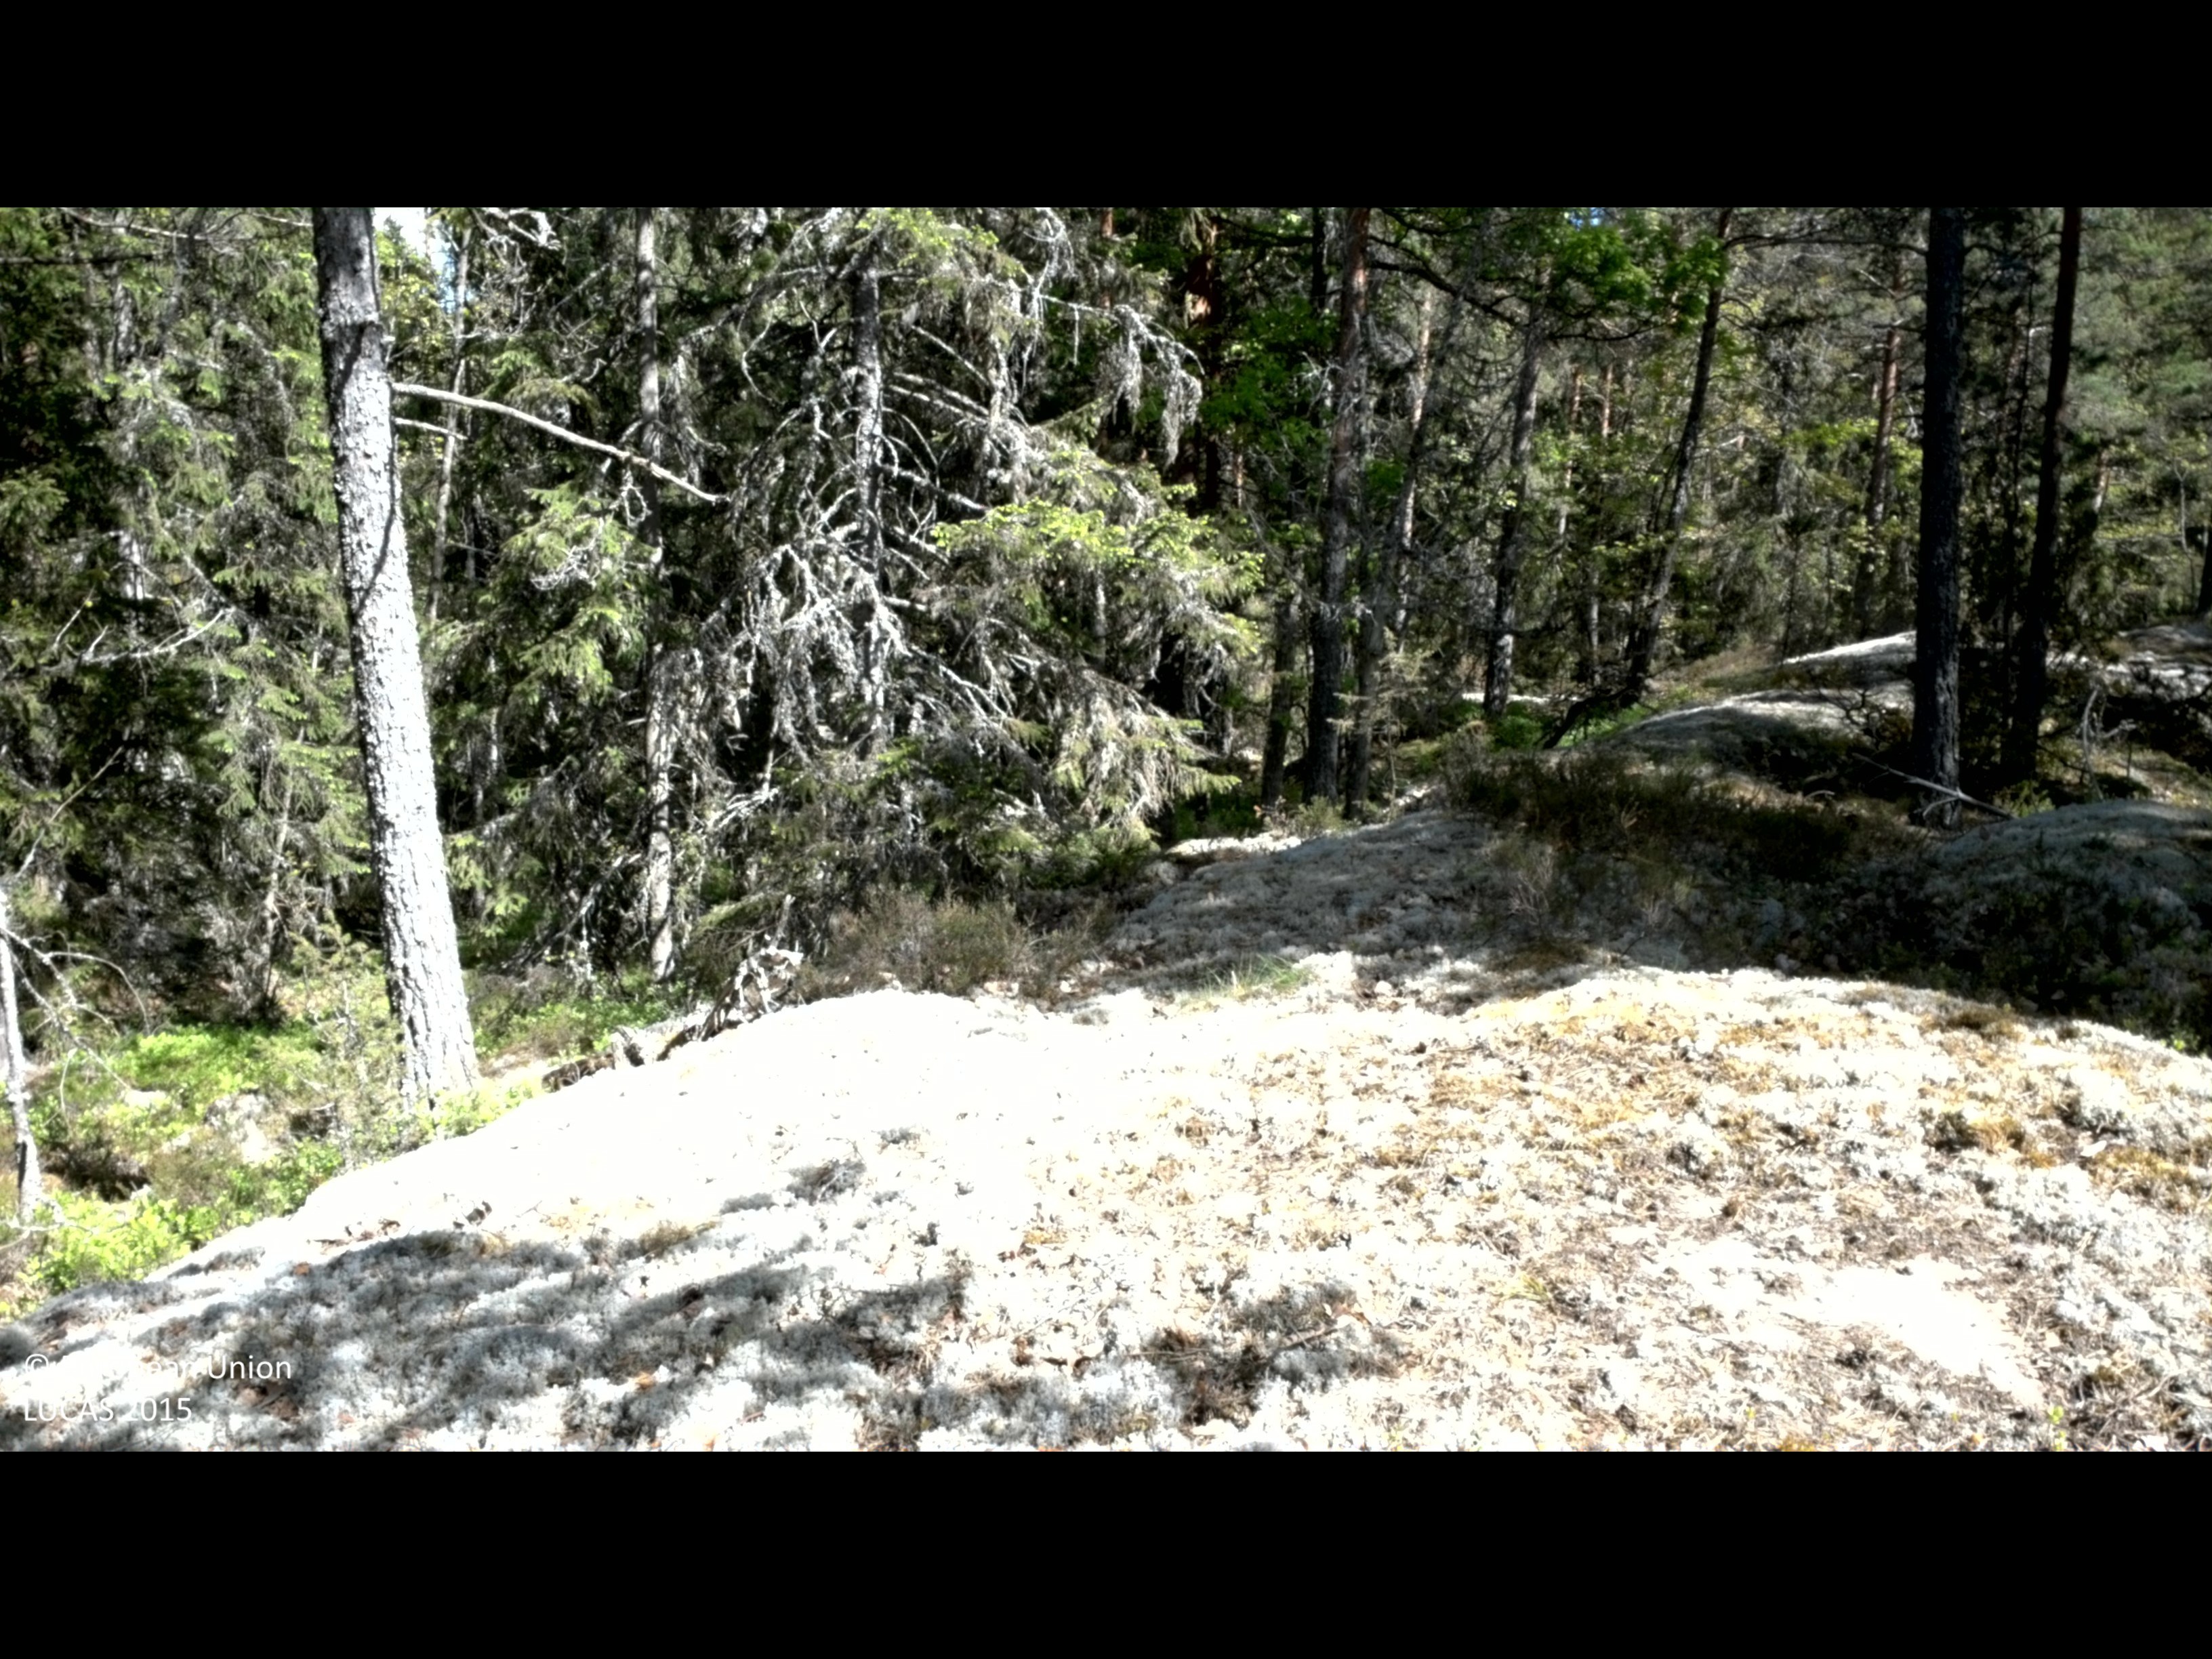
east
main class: Woodland
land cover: Pine dominated coniferous woodland
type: boreal forest
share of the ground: > 75 %
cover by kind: coniferous forest trees 80 %, shrubs 10 %, broadleaved forest trees 5 %, lichens and mosses 5 %
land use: Forestry
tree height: > 5 m
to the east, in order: Pine dominated coniferous woodland; Spruce dominated coniferous woodland
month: May
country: SE
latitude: 57.3026
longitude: 16.1565
